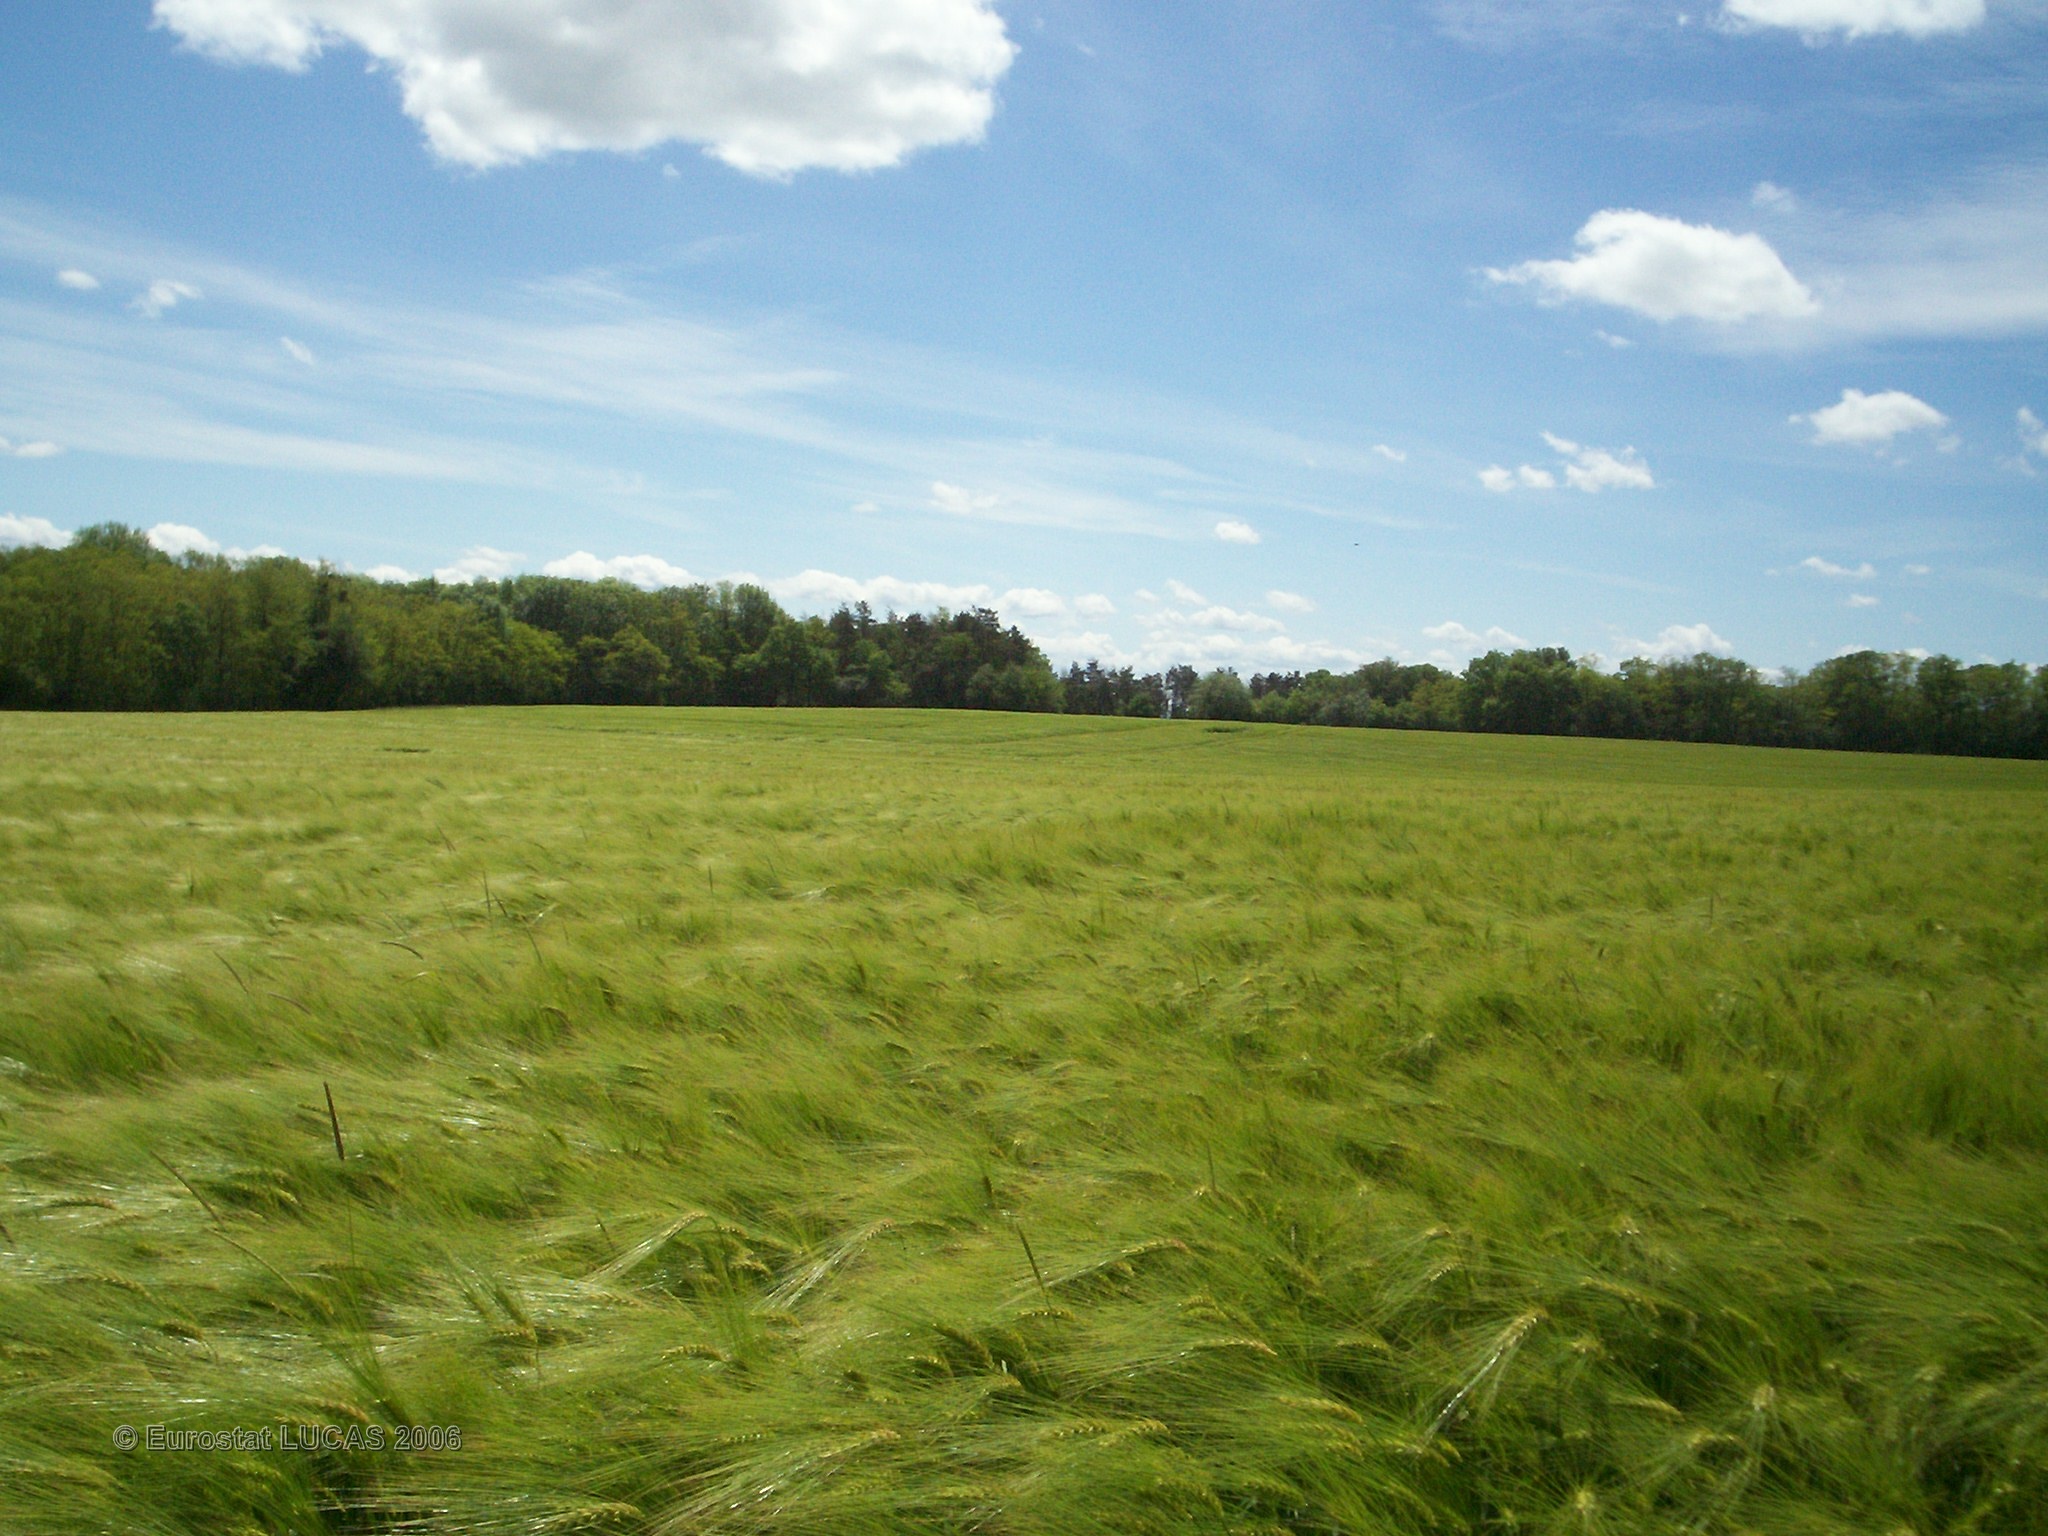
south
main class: Cropland
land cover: Barley
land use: Agriculture (excluding fallow land and kitchen gardens)
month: May
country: FR
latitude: 47.5953
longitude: 4.0797
